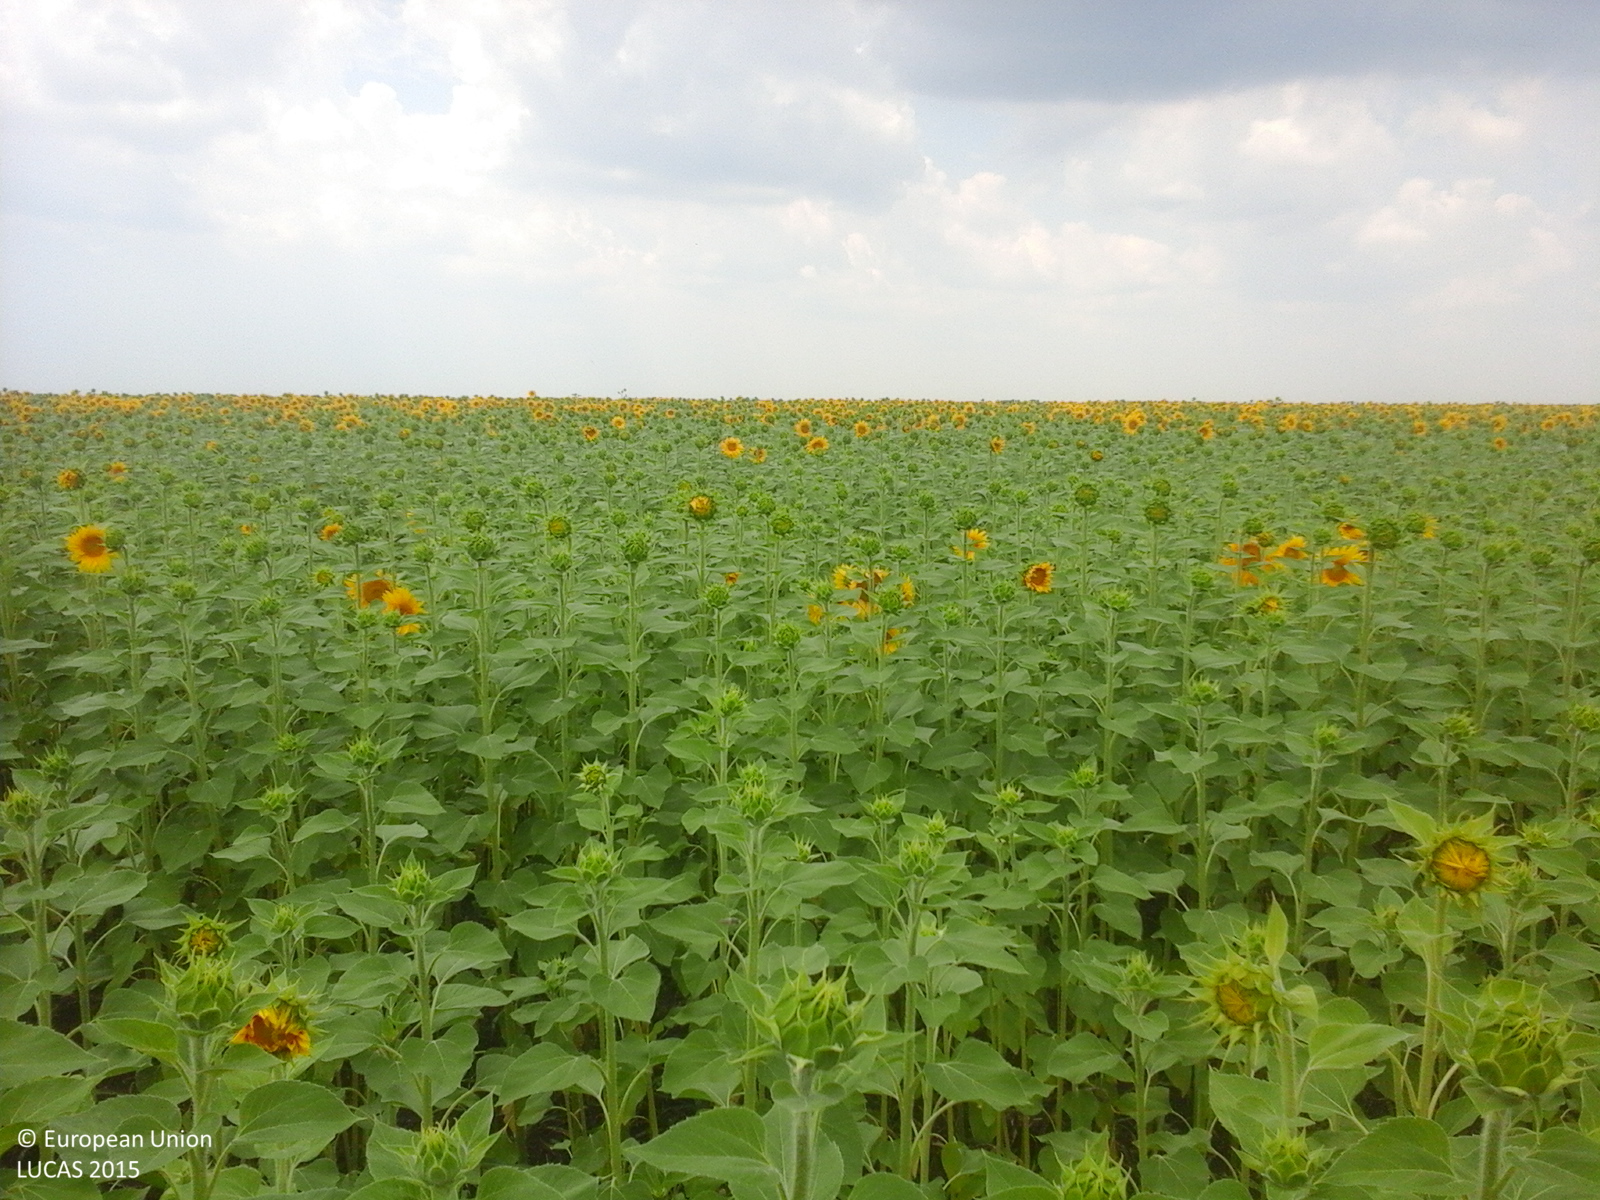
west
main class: Cropland
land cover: Sunflower
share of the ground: > 75 %
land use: Agriculture (excluding fallow land and kitchen gardens)
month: July
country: RO
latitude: 43.8902
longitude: 25.6362
